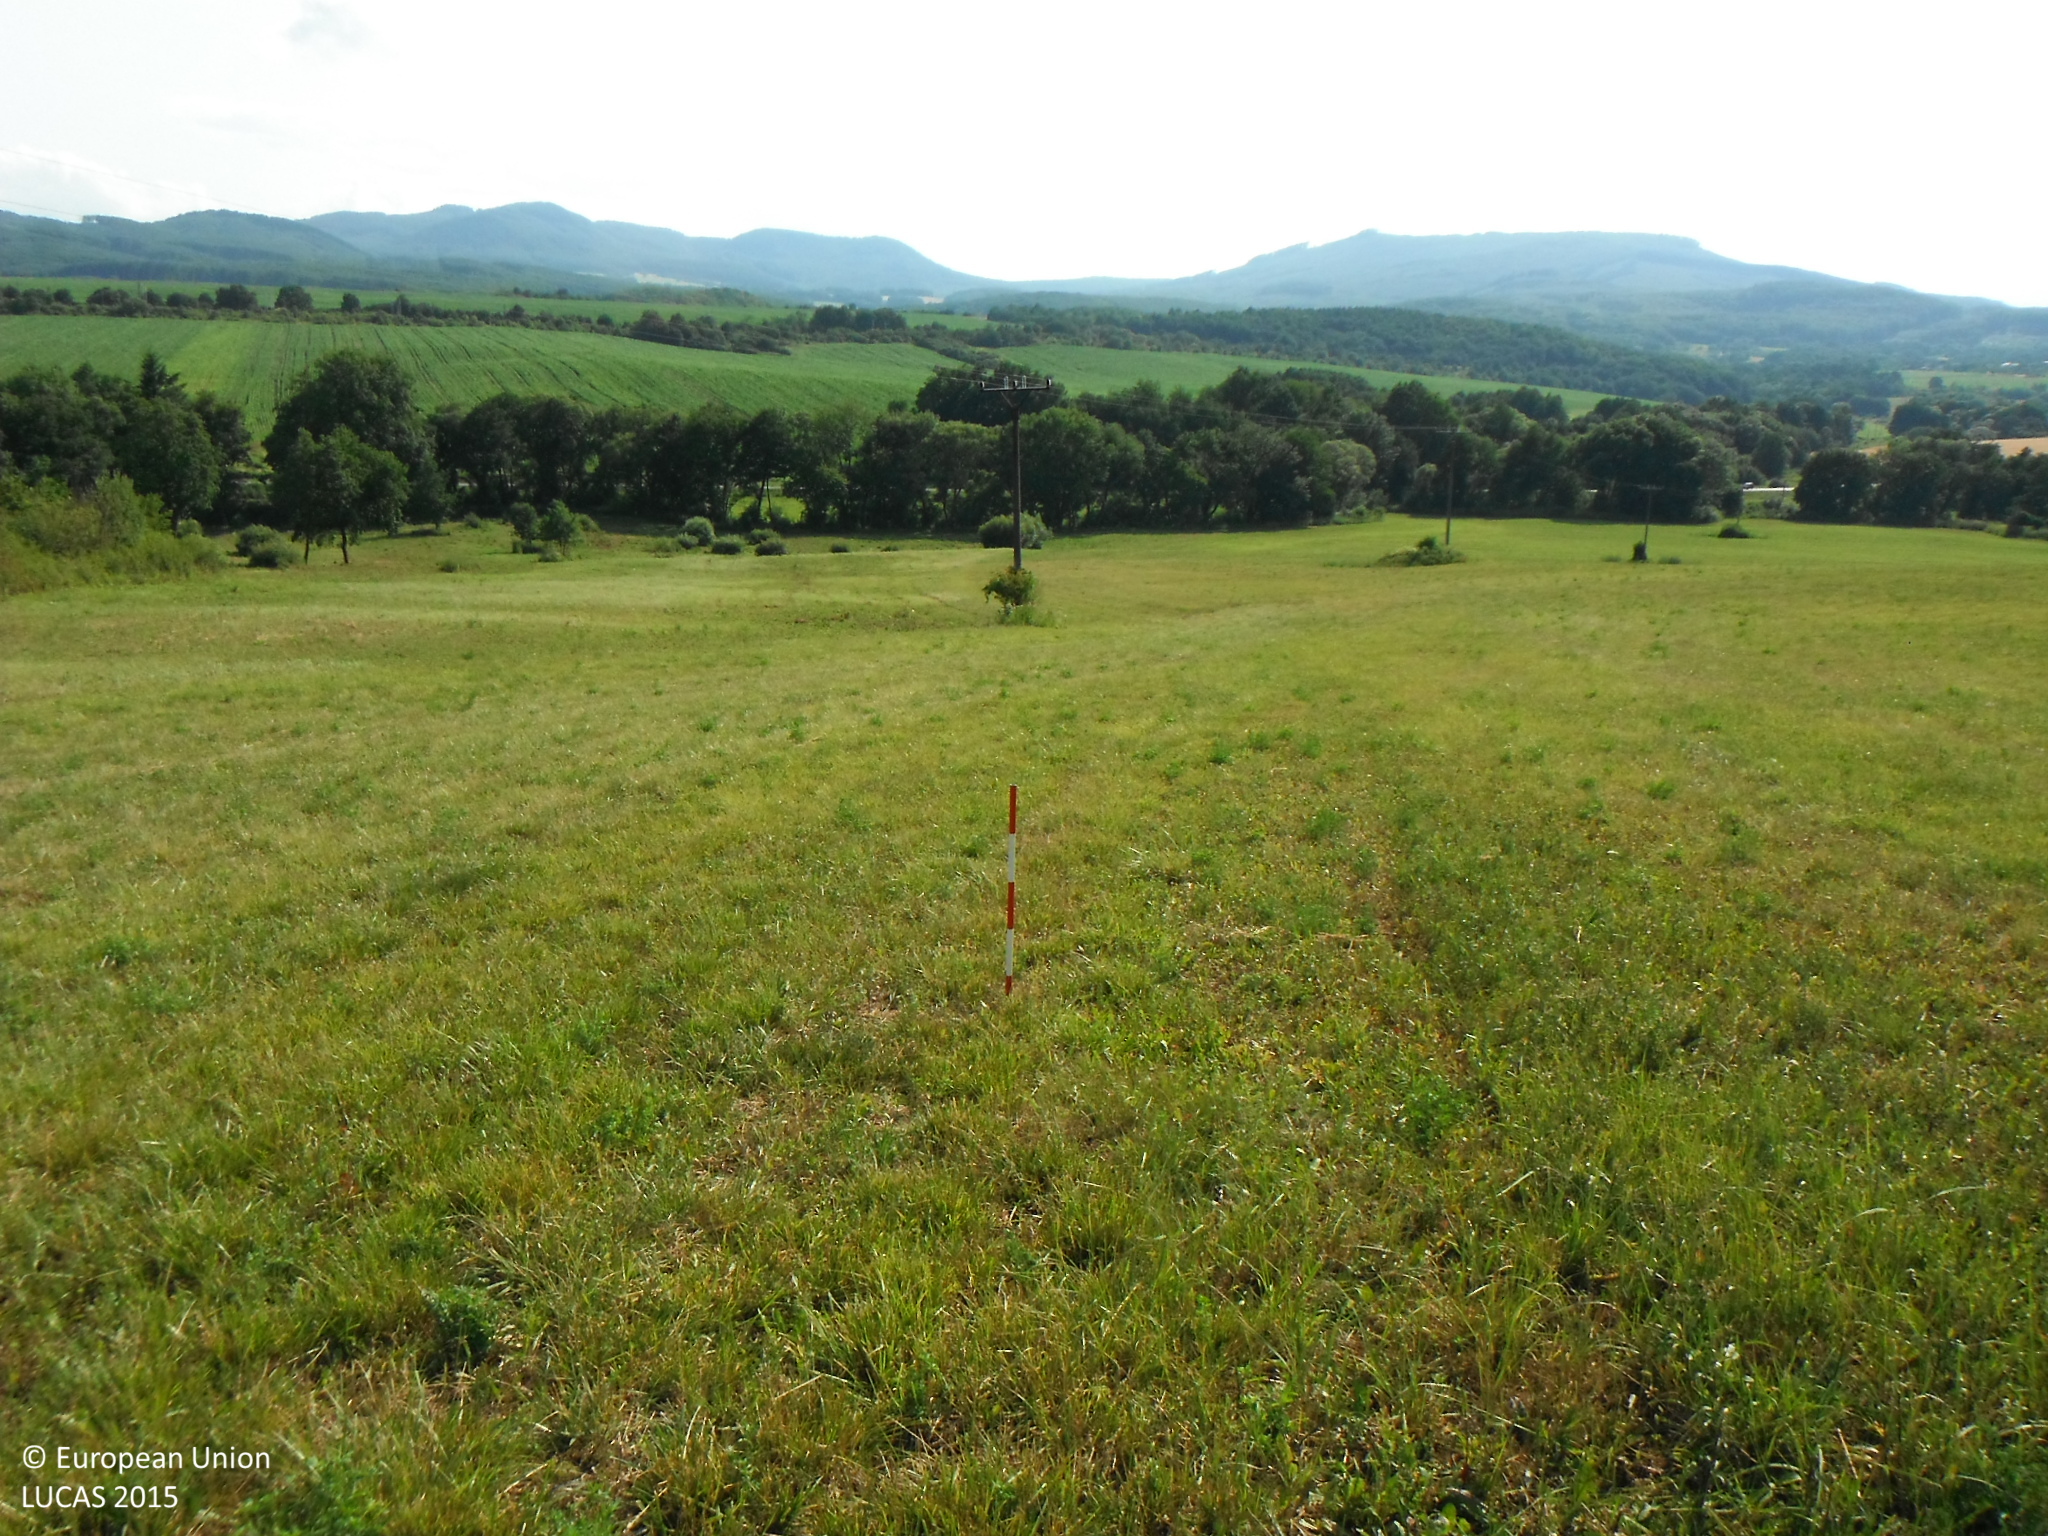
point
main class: Cropland
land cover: Other leguminous and mixtures for fodder
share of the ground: > 75 %
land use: Agriculture (excluding fallow land and kitchen gardens)
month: July
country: SK
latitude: 48.6357
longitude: 21.5143
